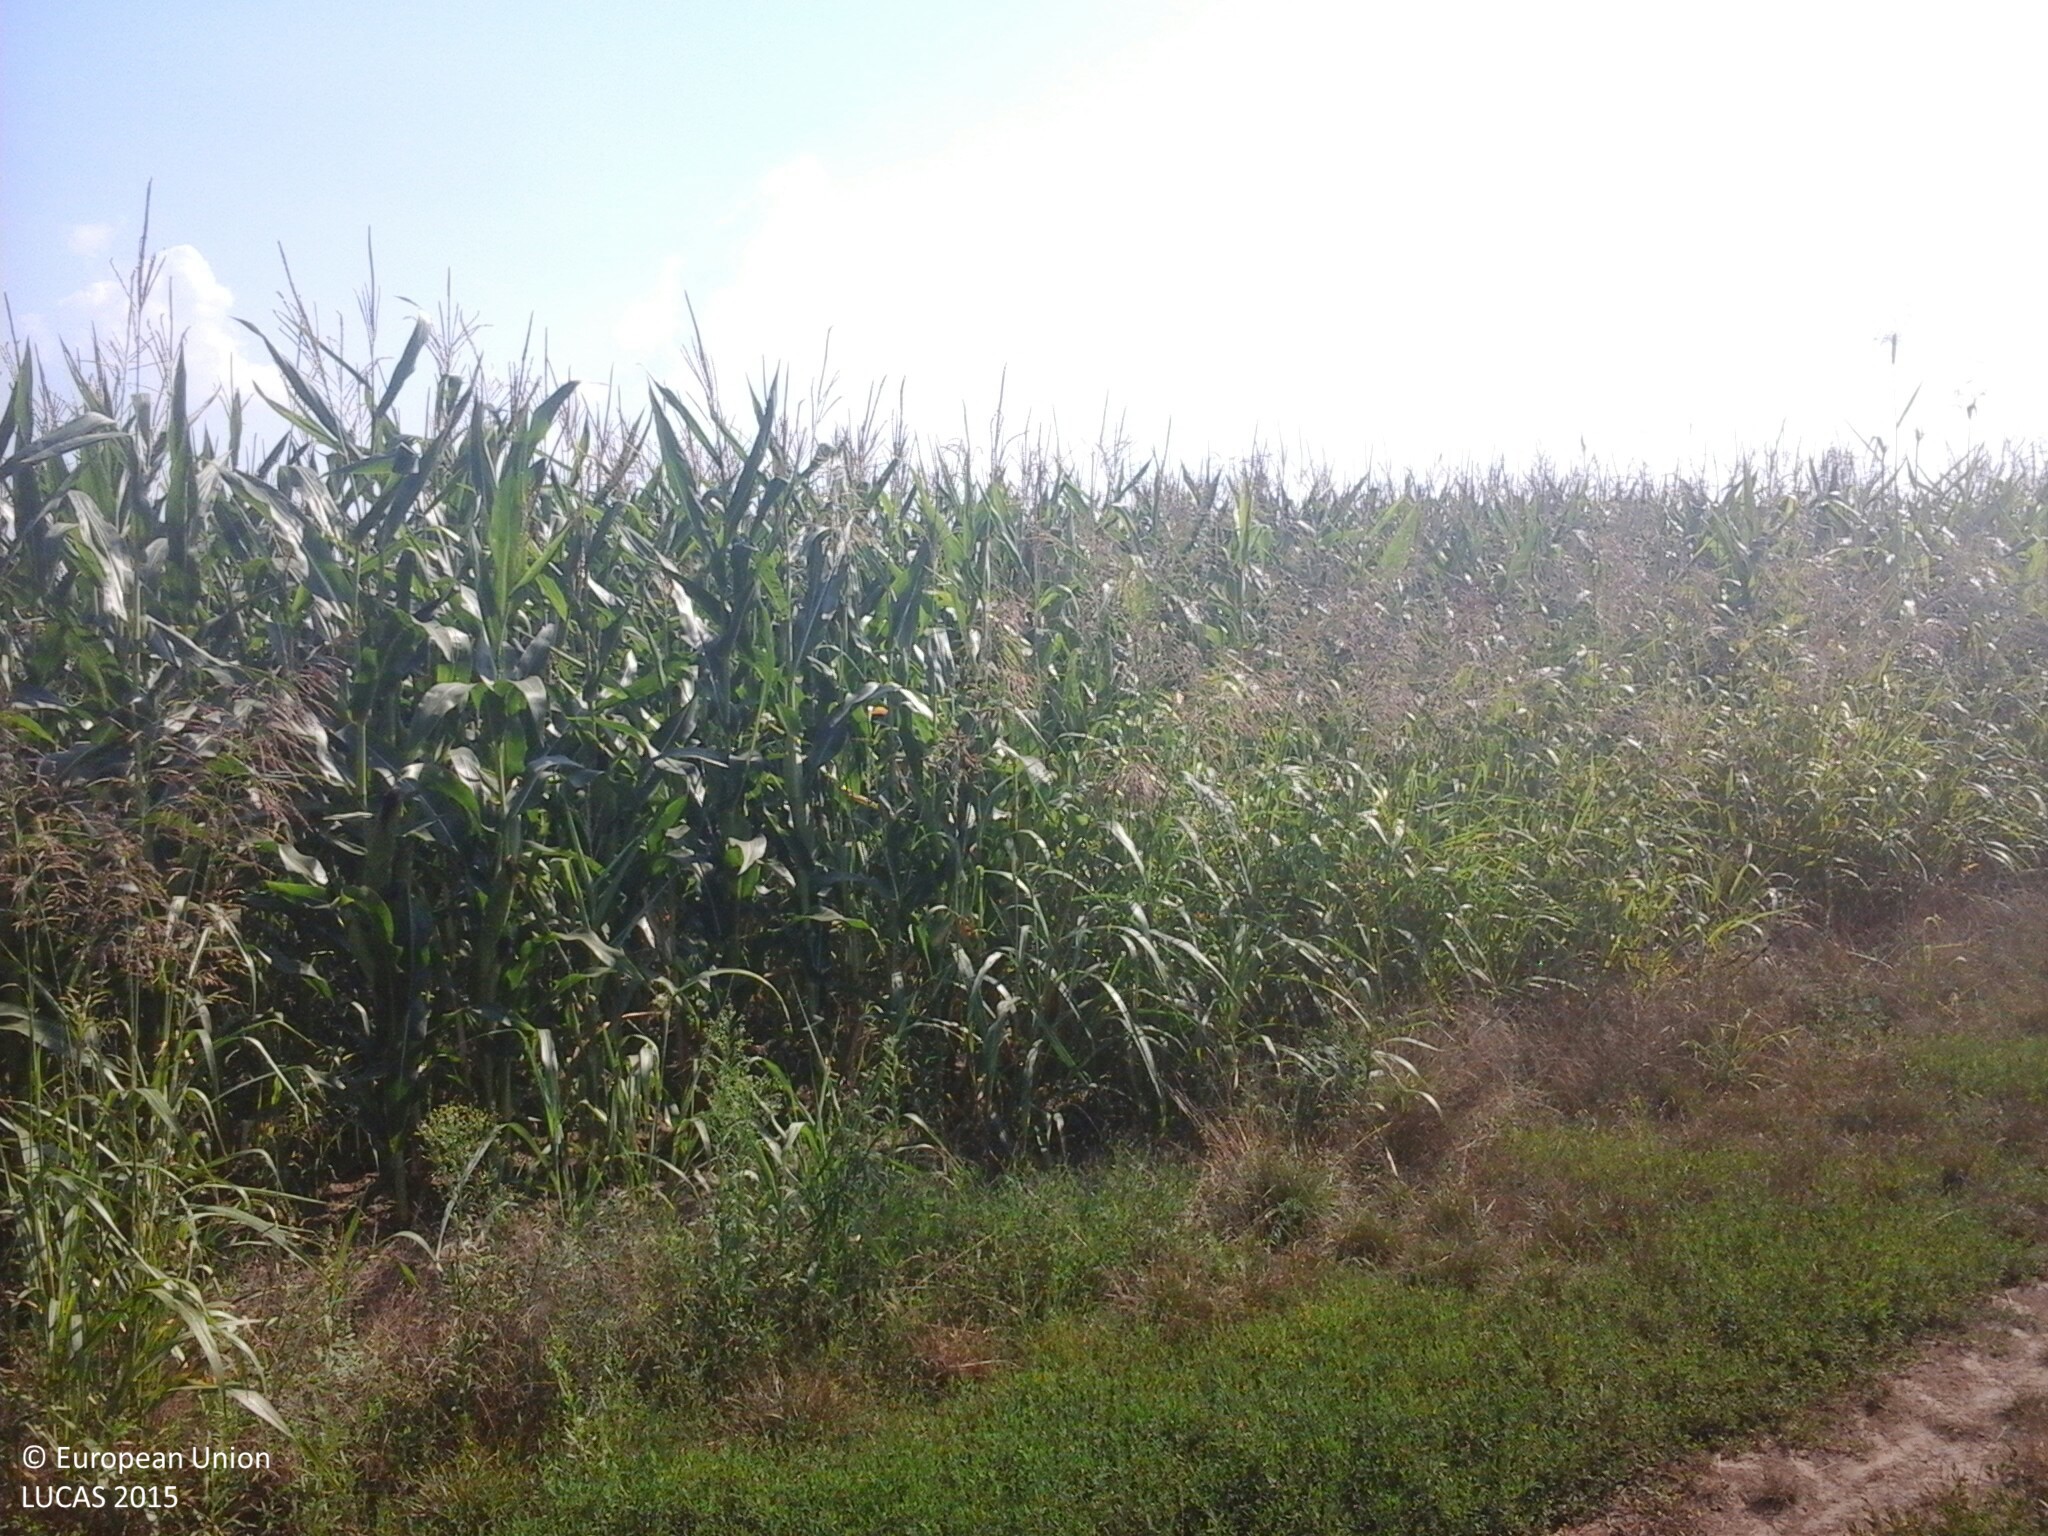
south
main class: Cropland
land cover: Maize
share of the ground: > 75 %
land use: Agriculture (excluding fallow land and kitchen gardens)
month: August
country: HU
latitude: 46.7919
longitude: 18.4873
